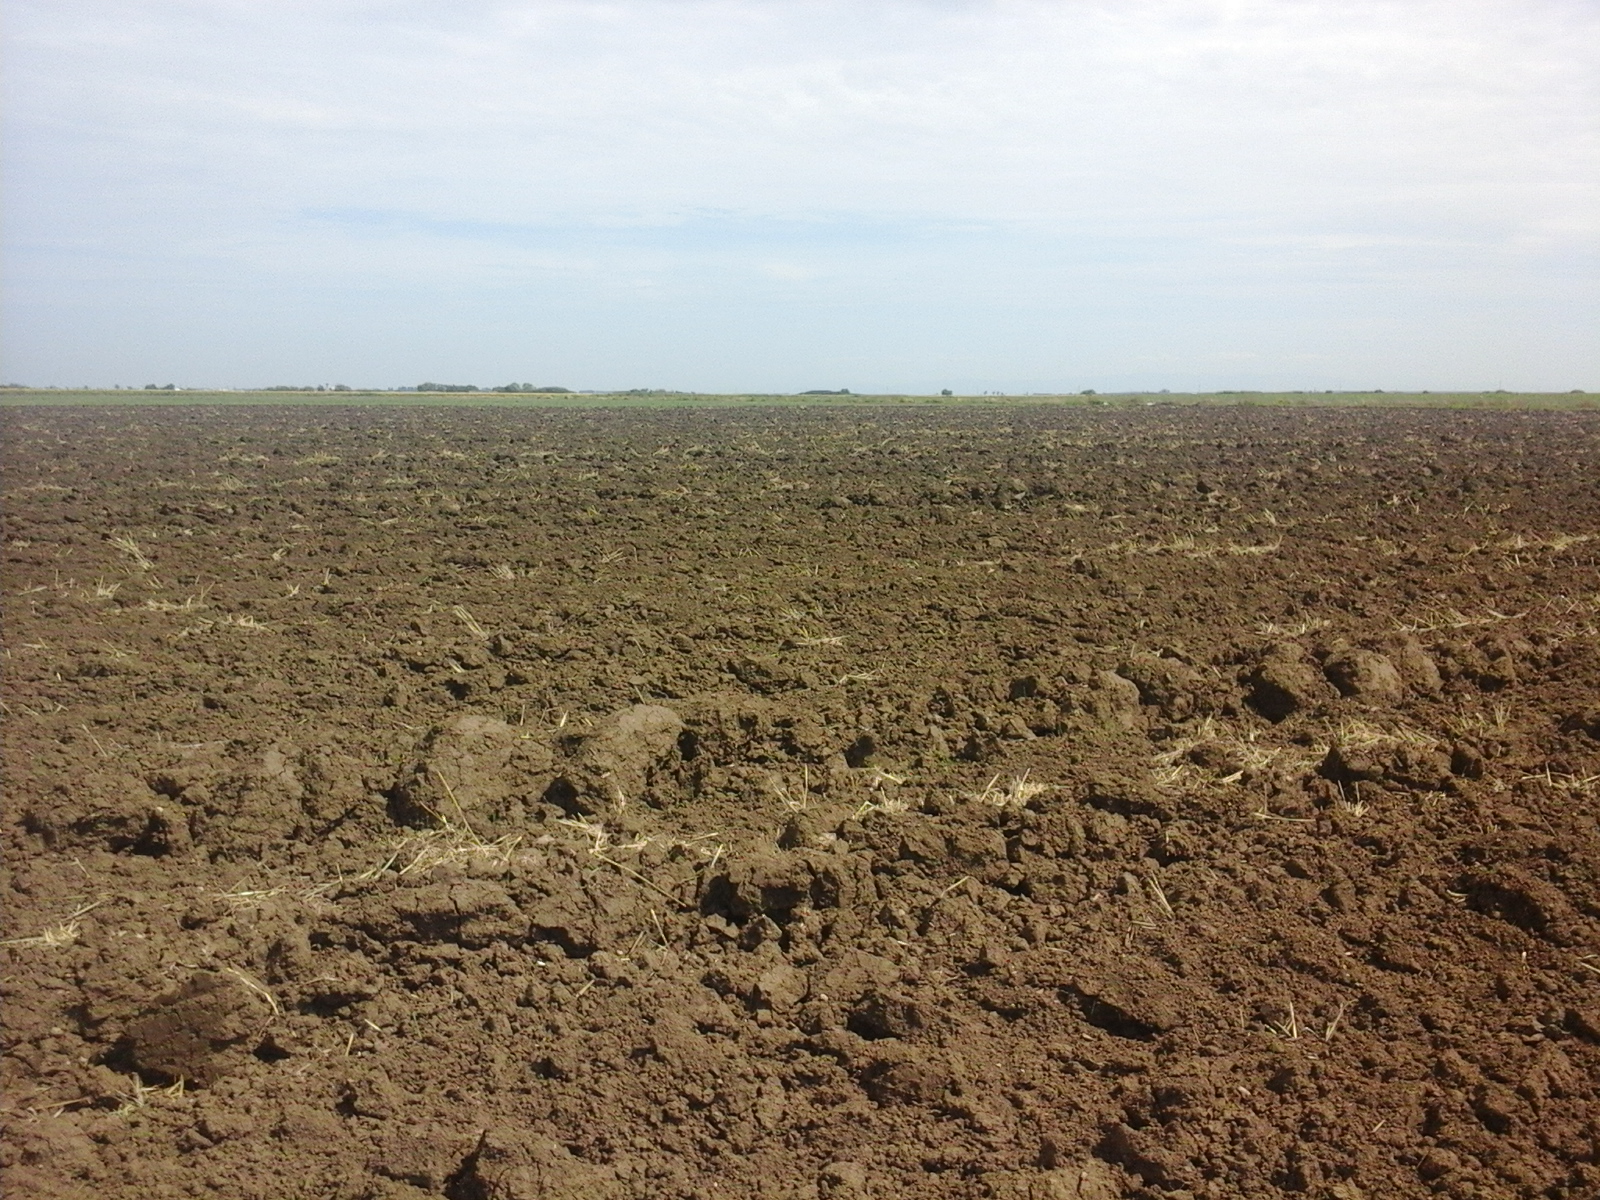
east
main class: Cropland
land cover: Common wheat
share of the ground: < 10 %
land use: Agriculture (excluding fallow land and kitchen gardens)
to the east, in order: Common wheat; Grass margins; Tracks; Grass margins; Ditches and canals; Grass margins; Lucerne
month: August
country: RO
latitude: 46.4813
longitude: 21.4345
